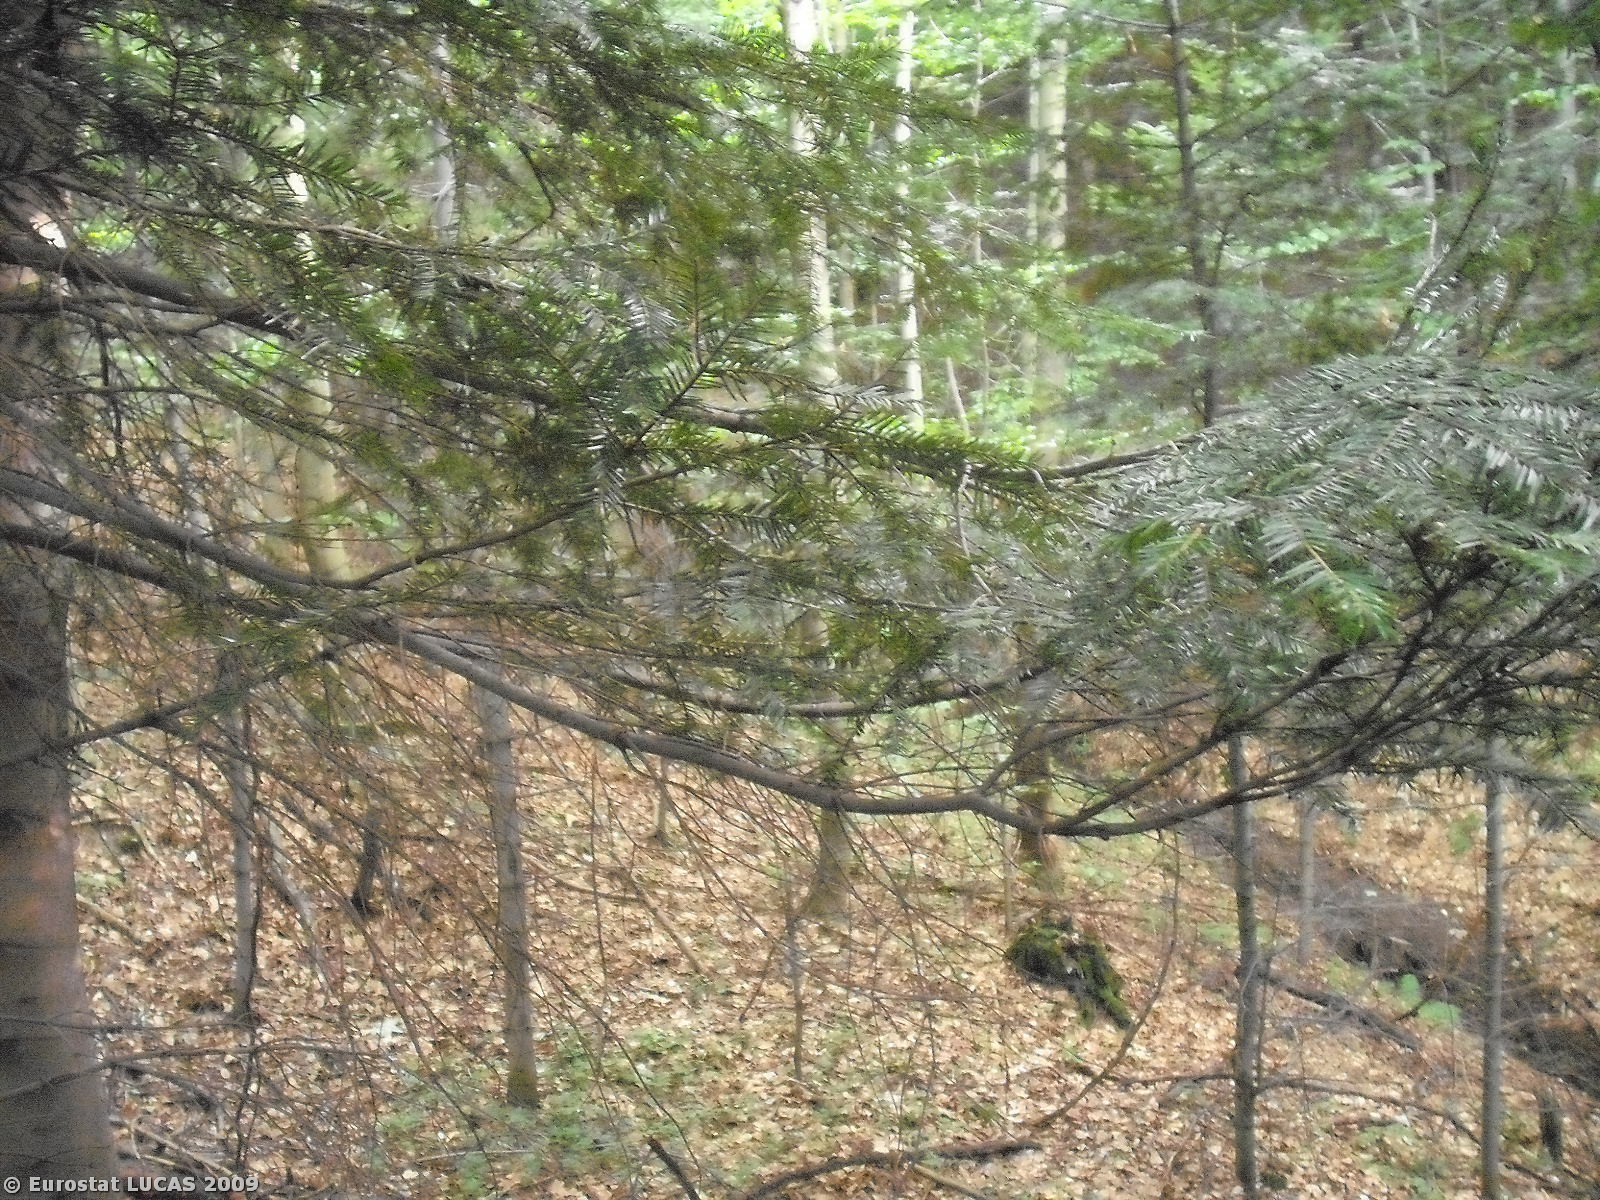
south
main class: Woodland
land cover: Mixed woodland
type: hemiboreal forest and nemoral coniferous forest and mixed broadleaved-coniferous forest
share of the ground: > 75 %
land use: Forestry
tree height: > 5 m
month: July
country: PL
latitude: 49.8982
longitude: 20.2954
